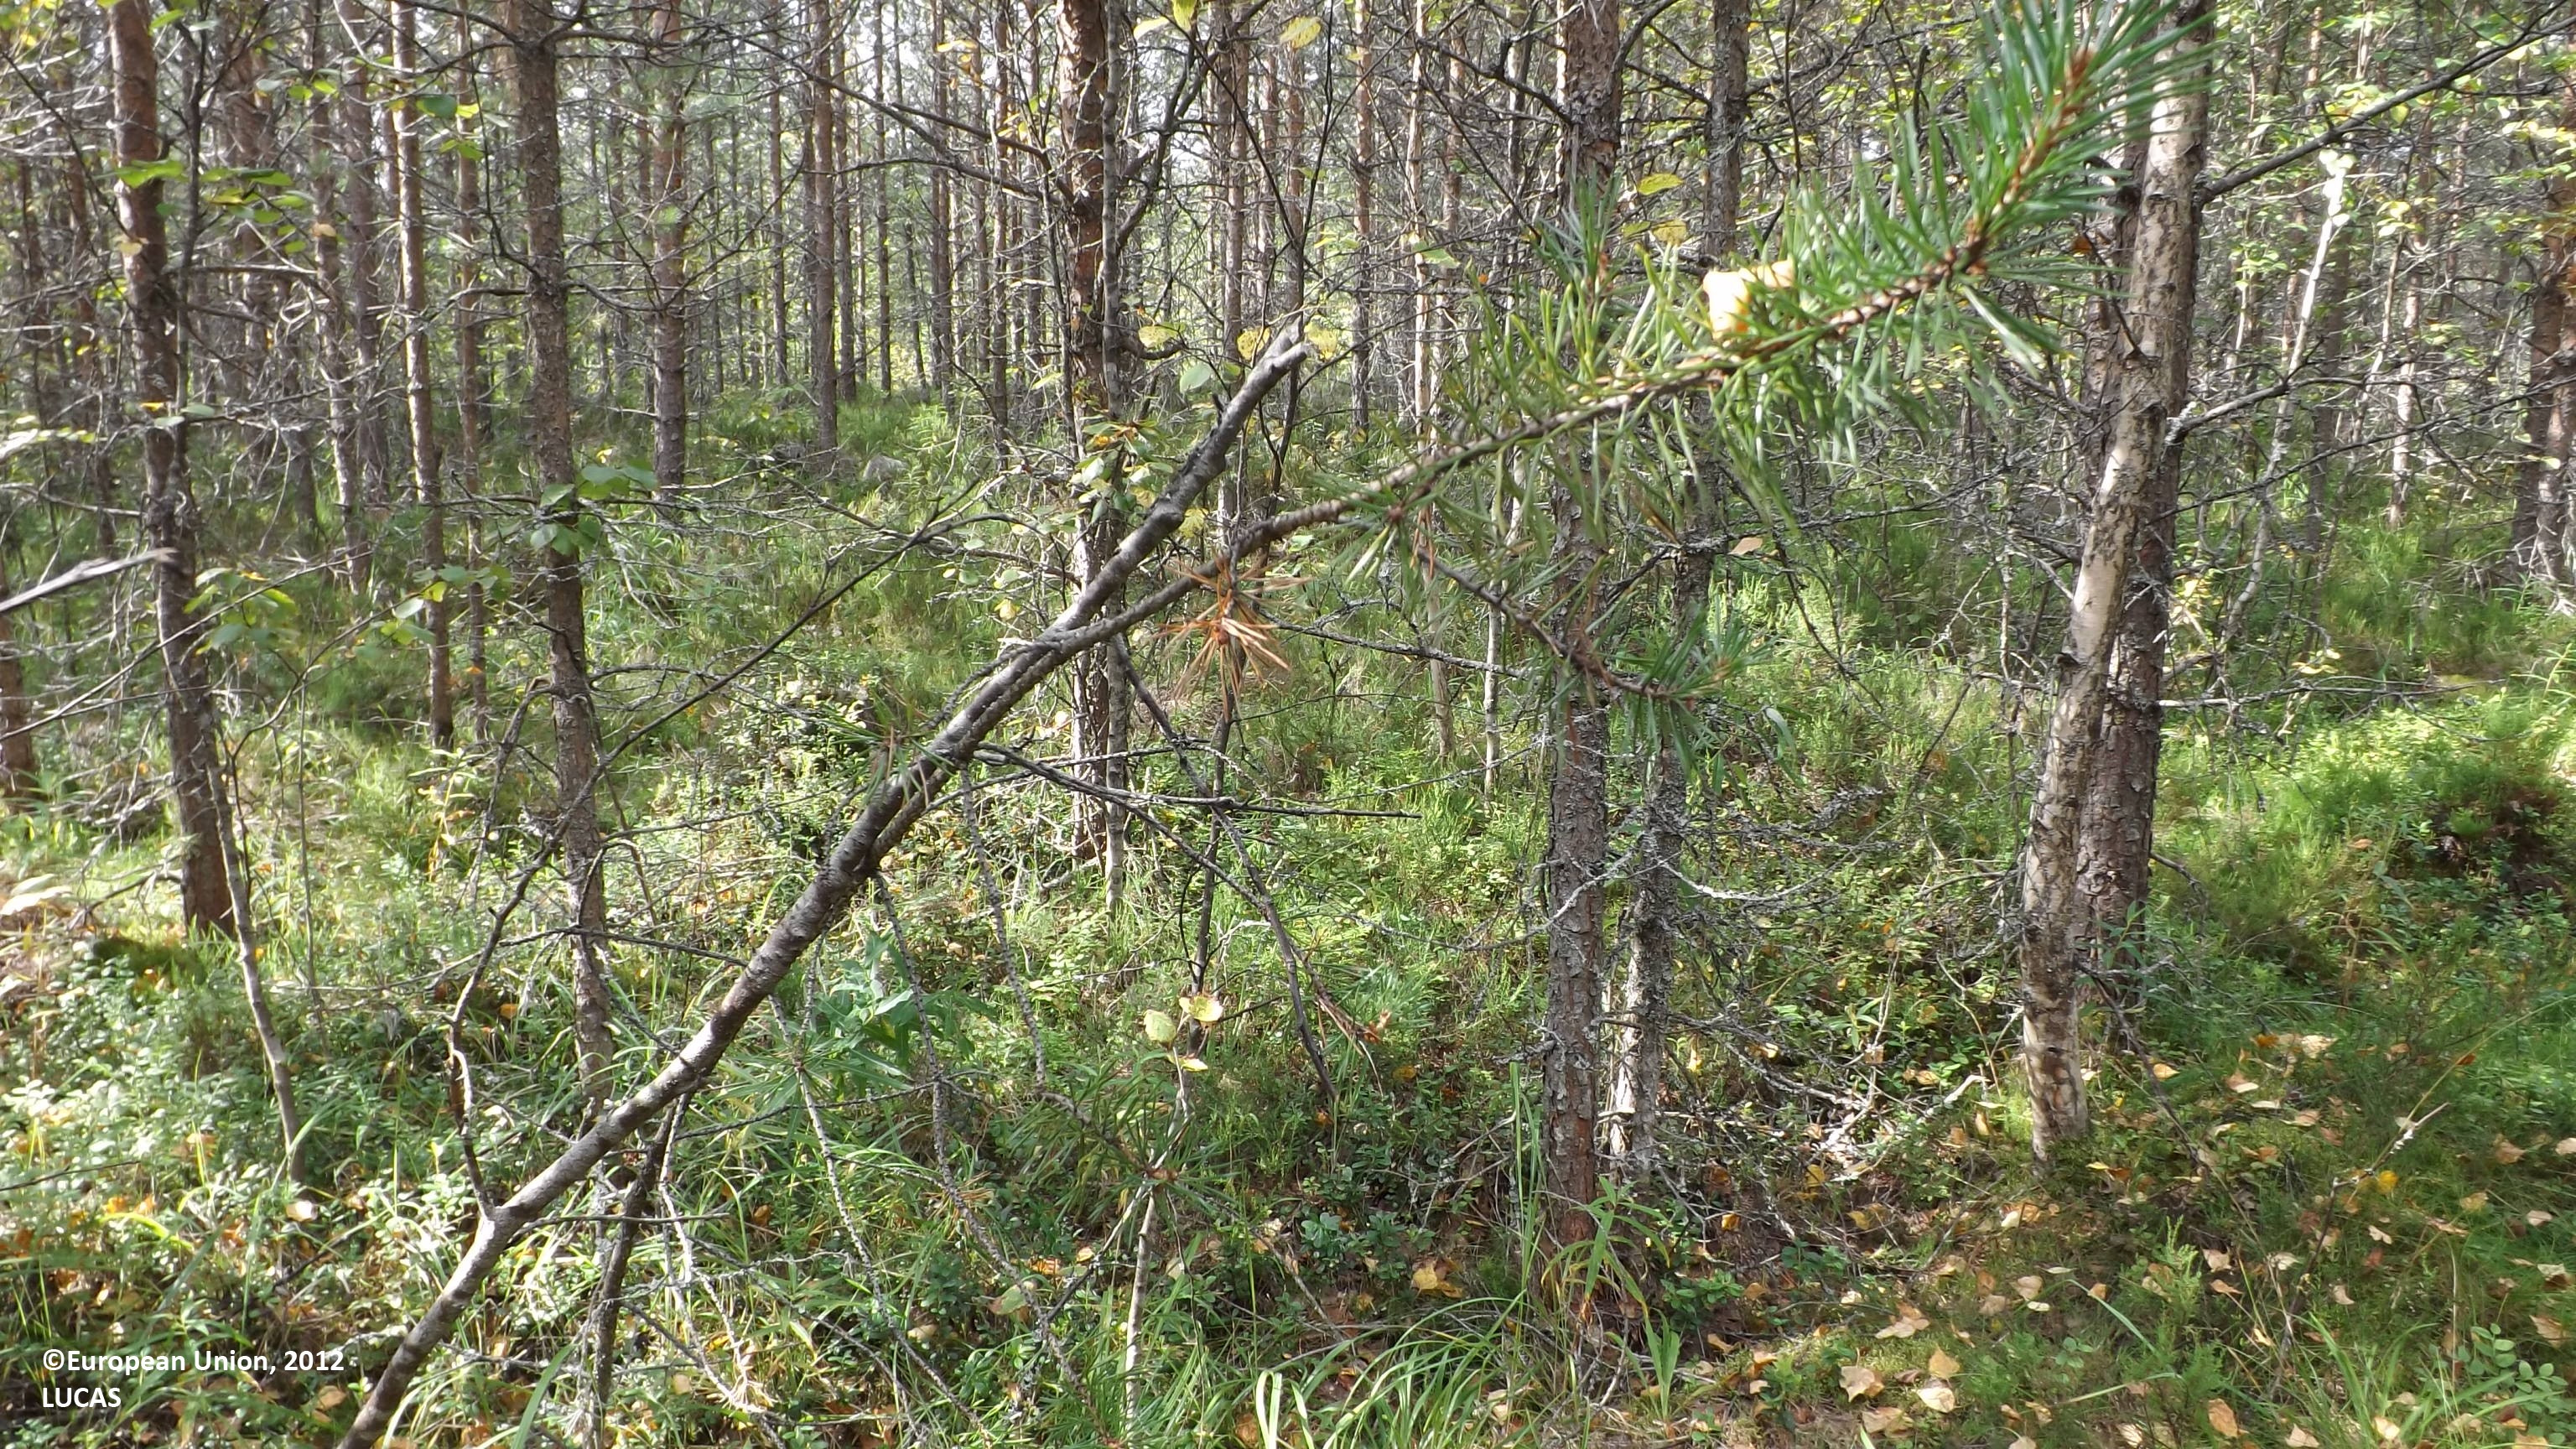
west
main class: Woodland
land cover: Pine dominated mixed woodland
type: boreal forest
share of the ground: > 75 %
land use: Forestry
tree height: > 5 m
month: August
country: FI
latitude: 63.0995
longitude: 24.3247
